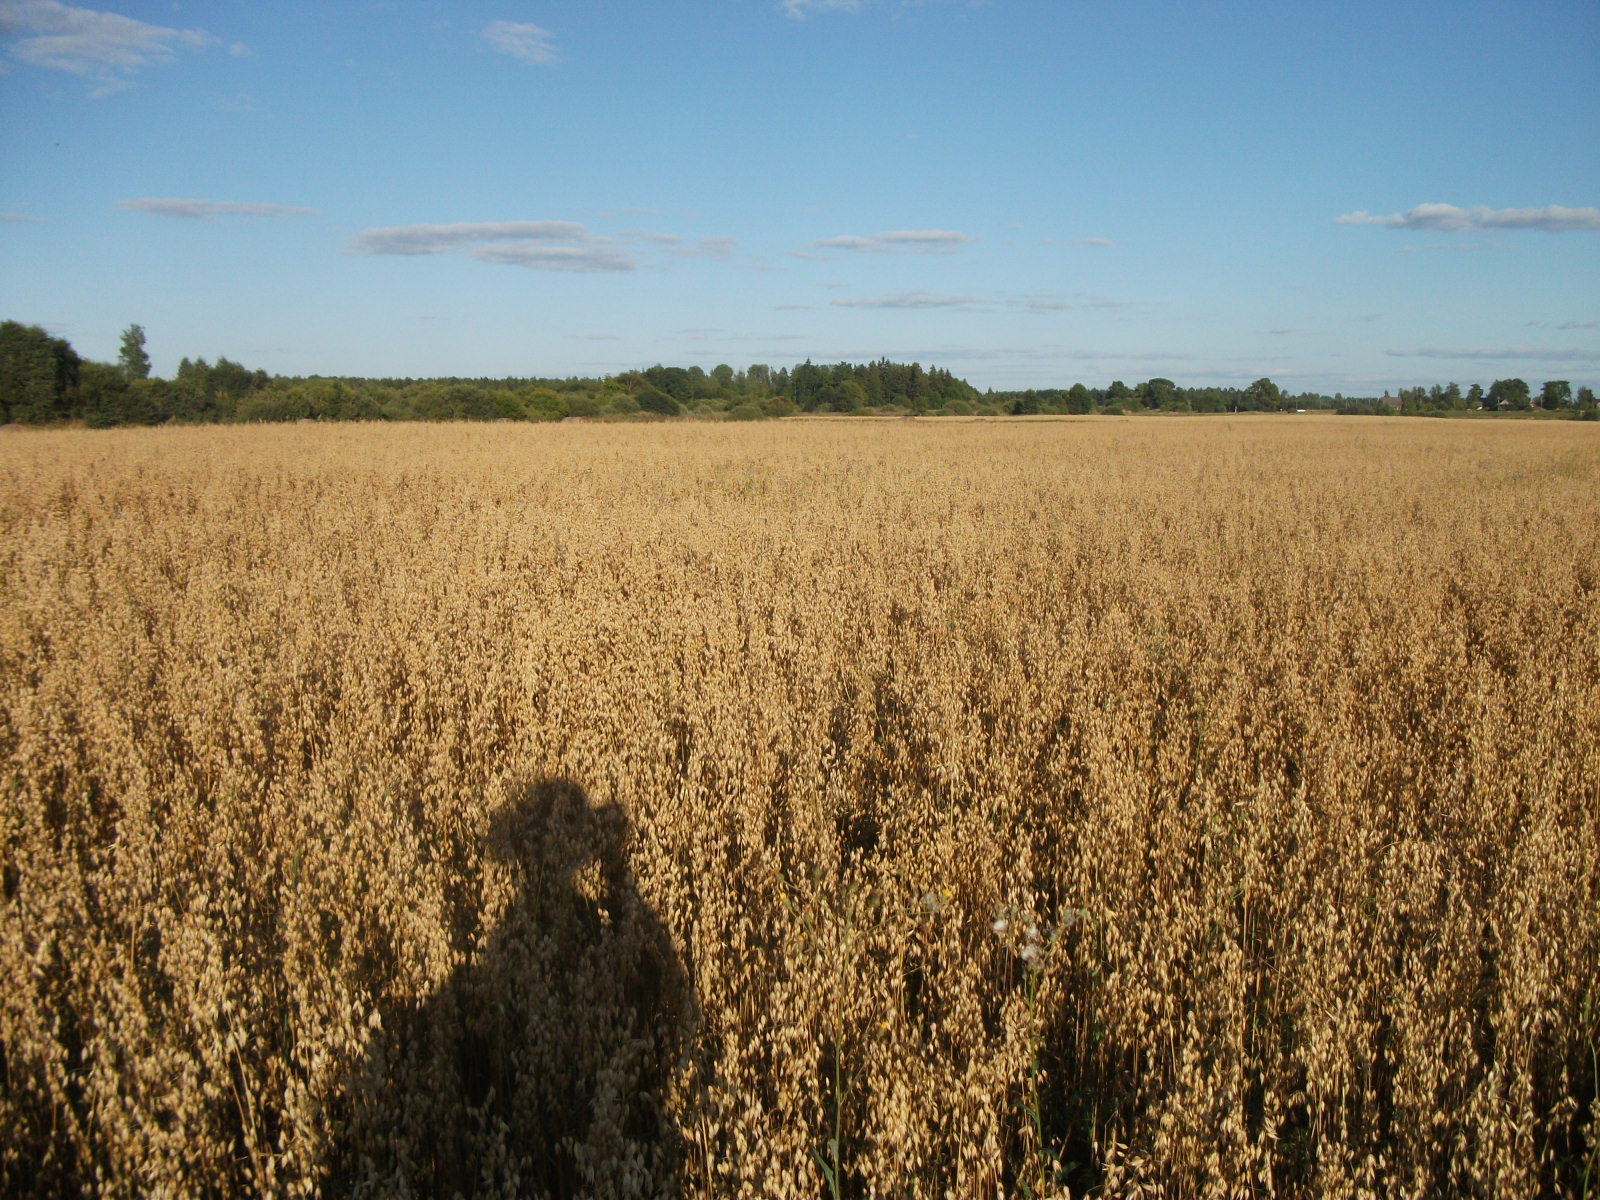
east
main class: Cropland
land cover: Oats
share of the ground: > 75 %
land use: Agriculture (excluding fallow land and kitchen gardens)
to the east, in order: Oats; Grassland without tree/shrub cover; Shruby margins; Ditches and canals; Spontaneously vegetated surfaces; Broadleaved woodland; Grass margins; Paved roads, cycling and walking lanes
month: August
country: LV
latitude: 56.3612
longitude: 26.3464
